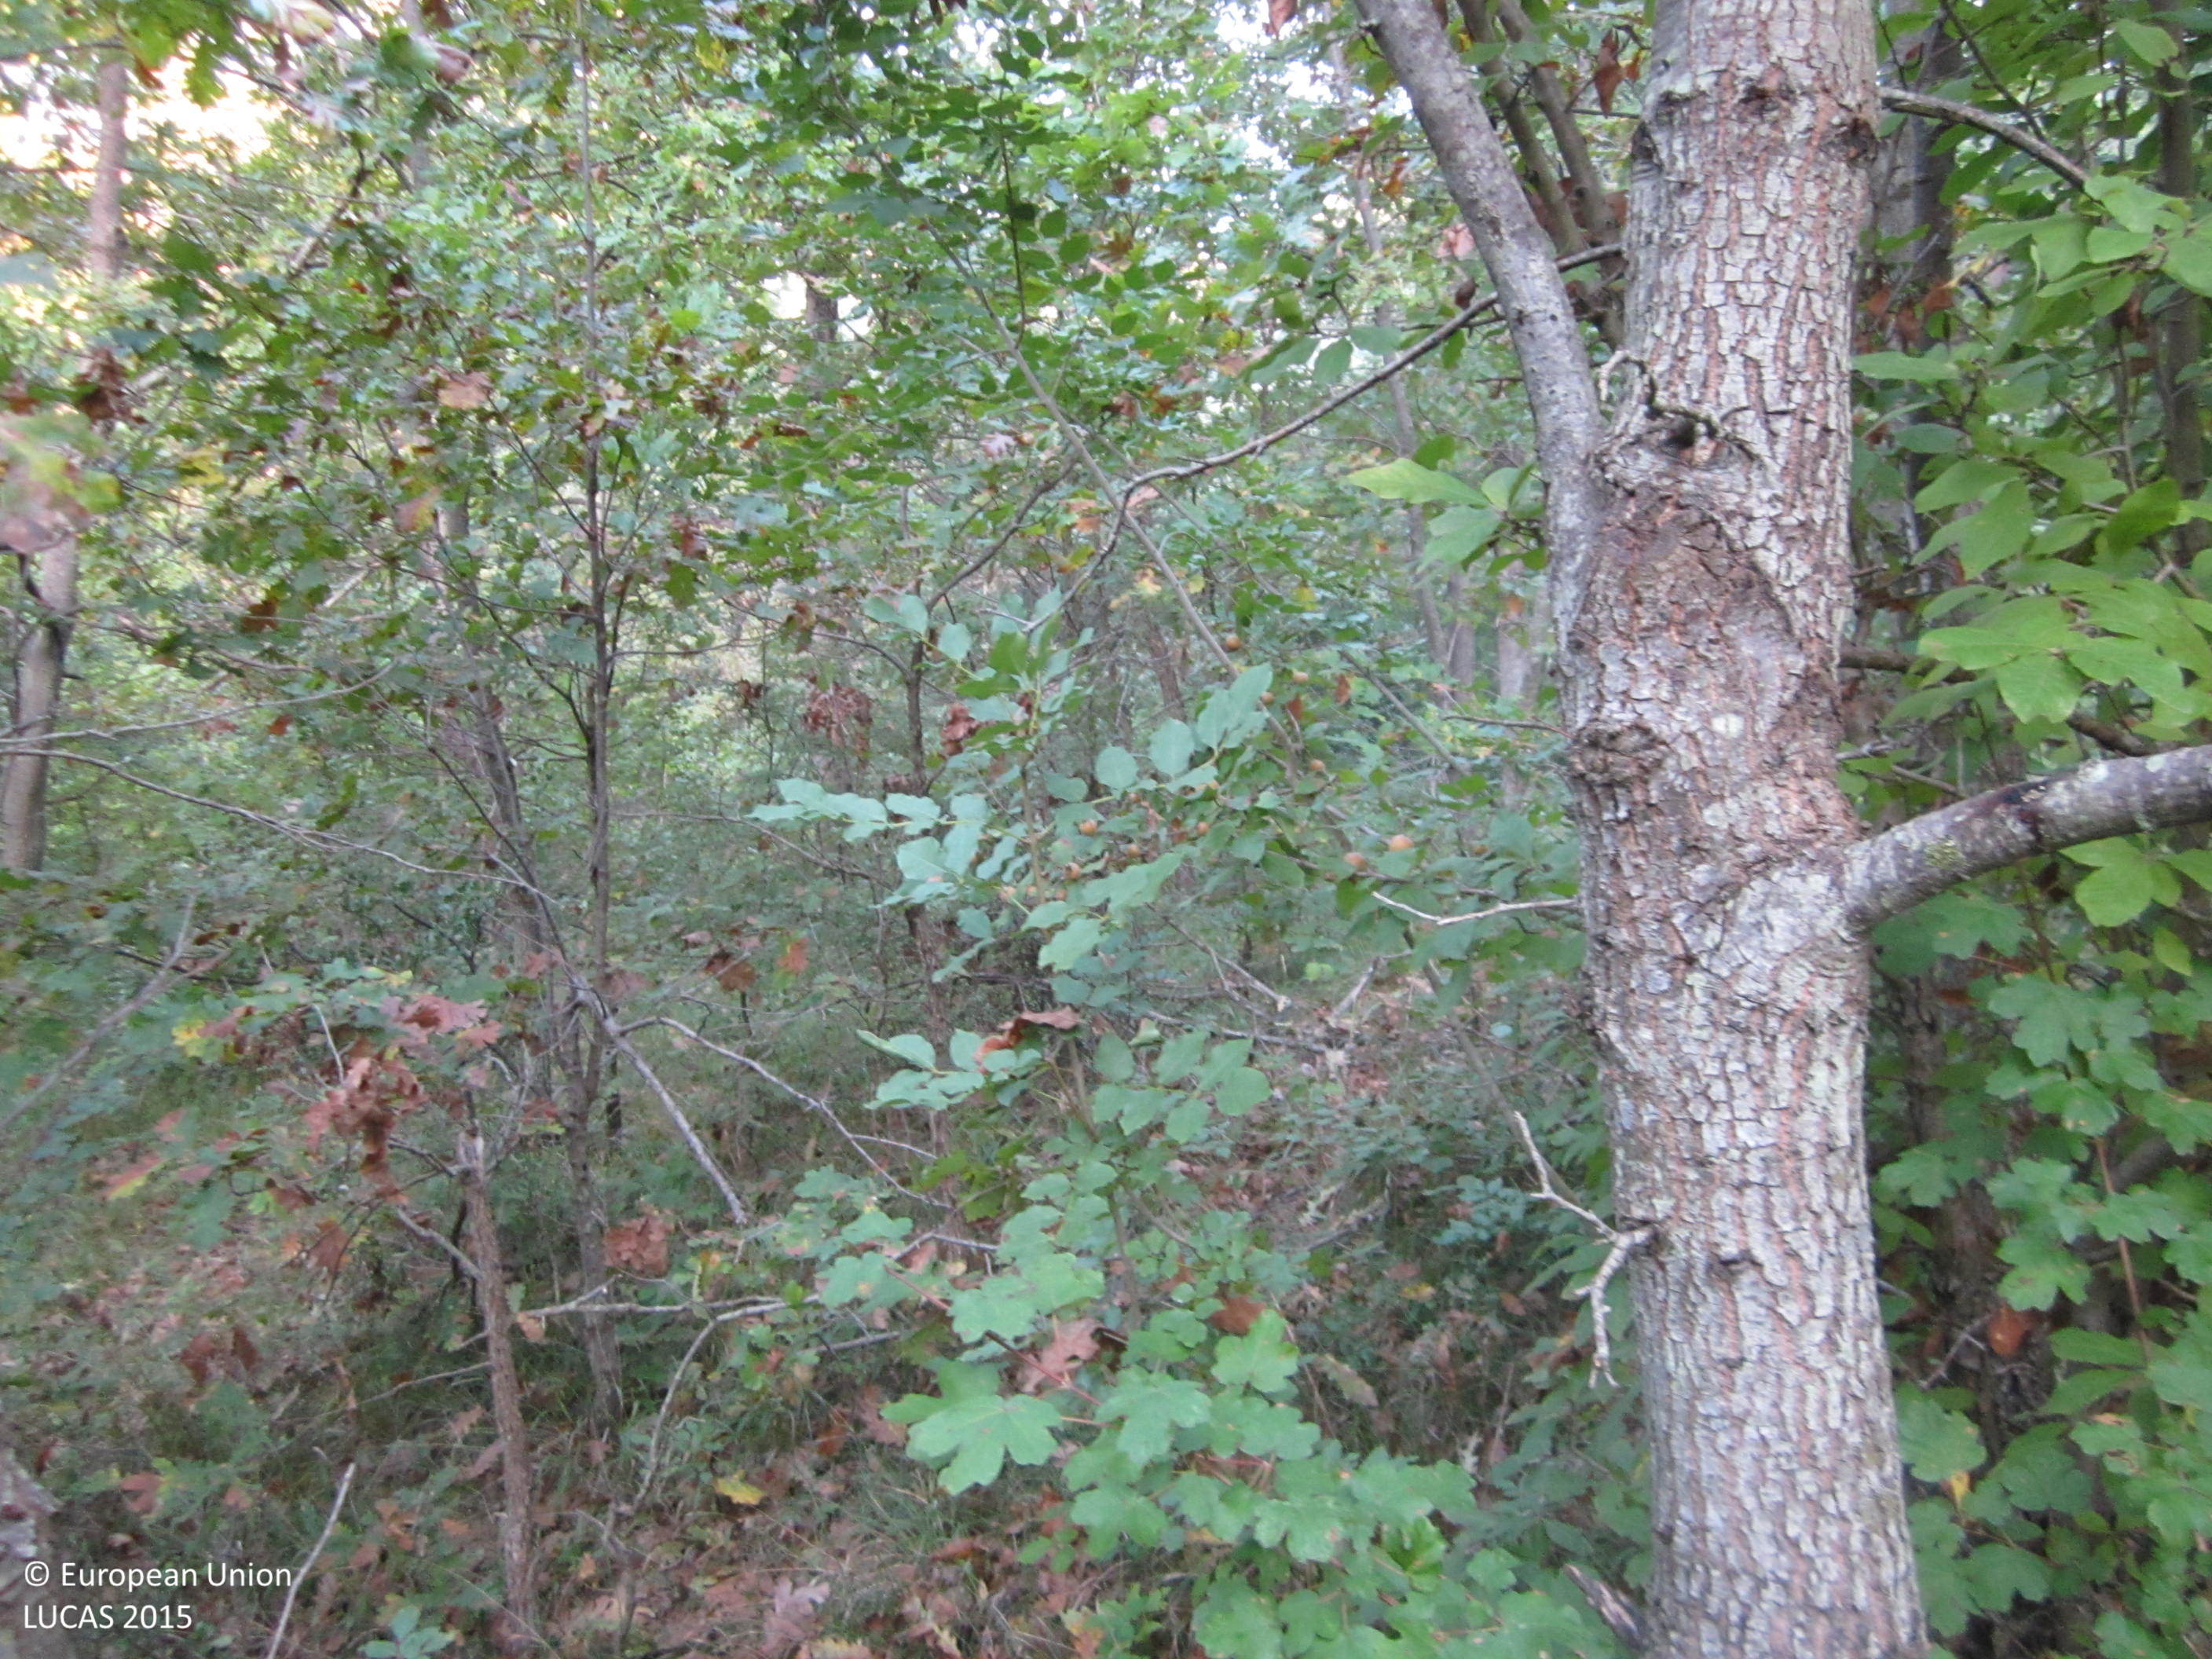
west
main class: Woodland
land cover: Broadleaved woodland
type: thermophilous deciduous forest
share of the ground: > 75 %
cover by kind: broadleaved forest trees 90 %, herbaceous plants 5 %, unconsolidated bare surface 5 %
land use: Forestry
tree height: > 5 m
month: September
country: BG
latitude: 42.1506
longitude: 27.8012
